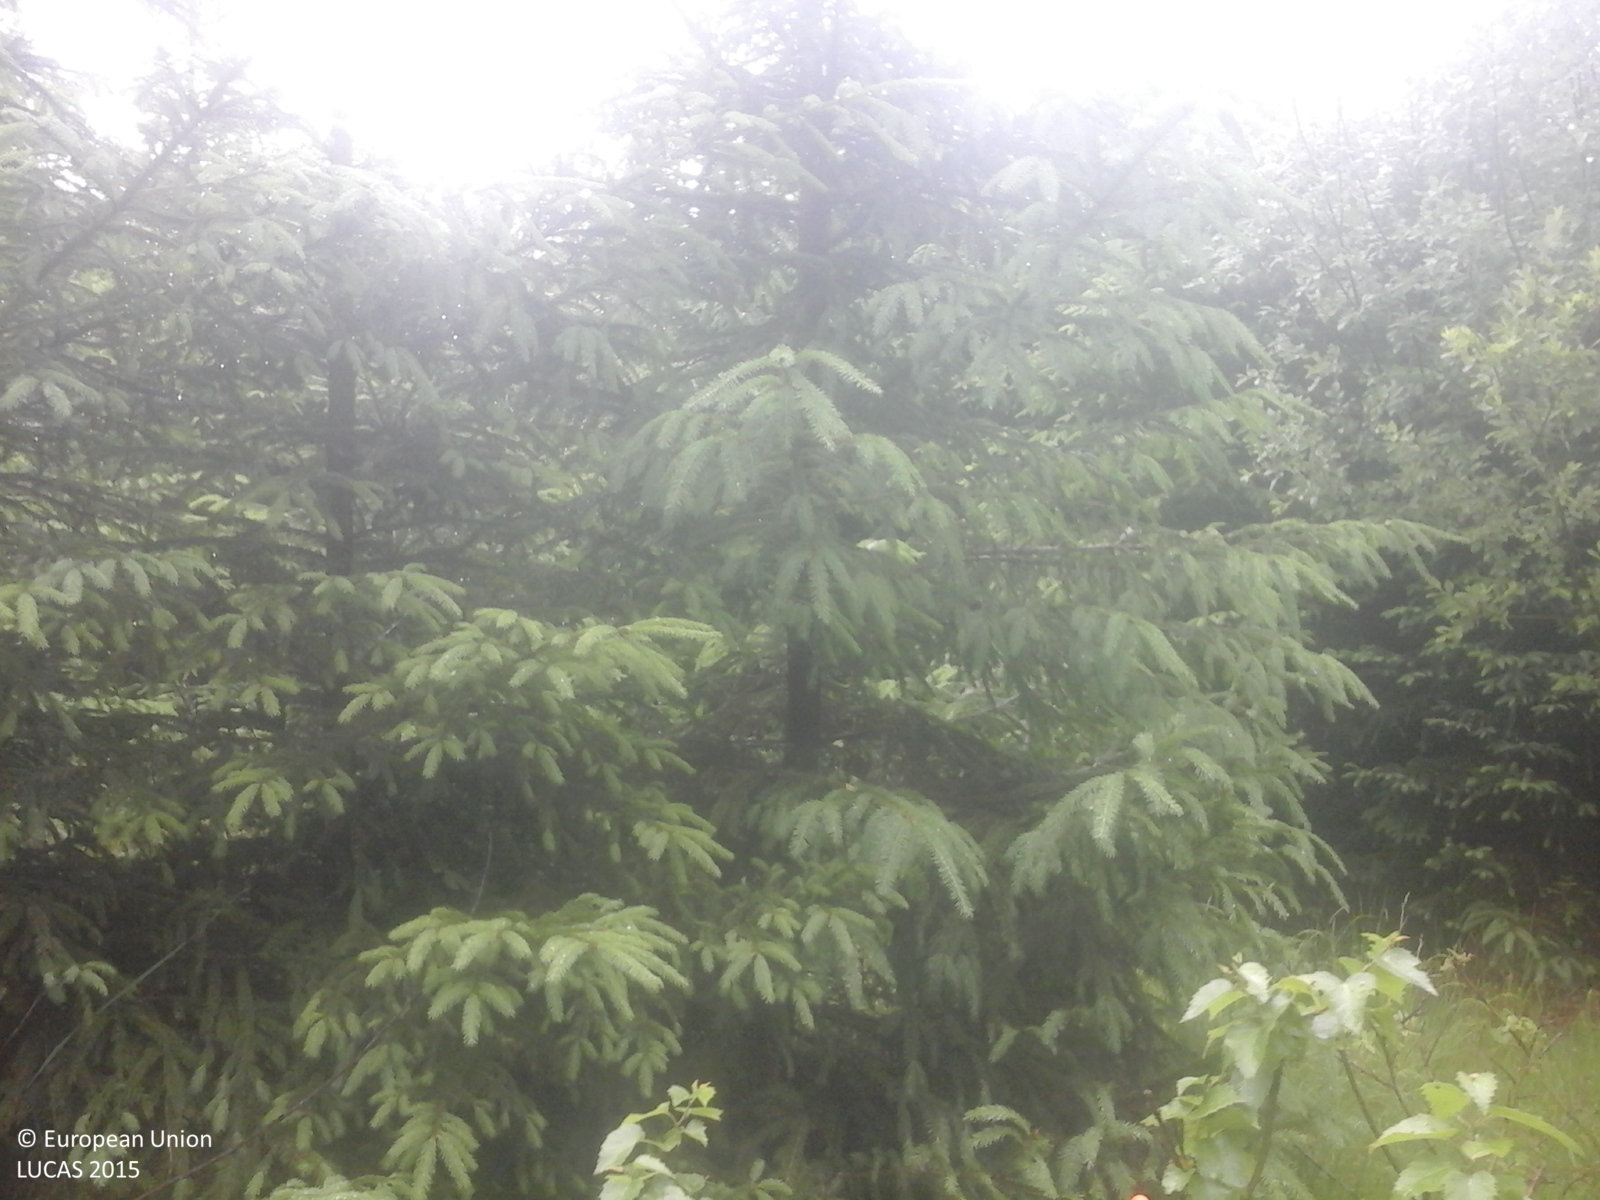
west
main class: Woodland
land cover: Spruce dominated coniferous woodland
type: alpine coniferous forest
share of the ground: > 75 %
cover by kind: coniferous forest trees 85 %, herbaceous plants 15 %
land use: Forestry
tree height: > 5 m
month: June
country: RO
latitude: 47.5351
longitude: 25.7853
